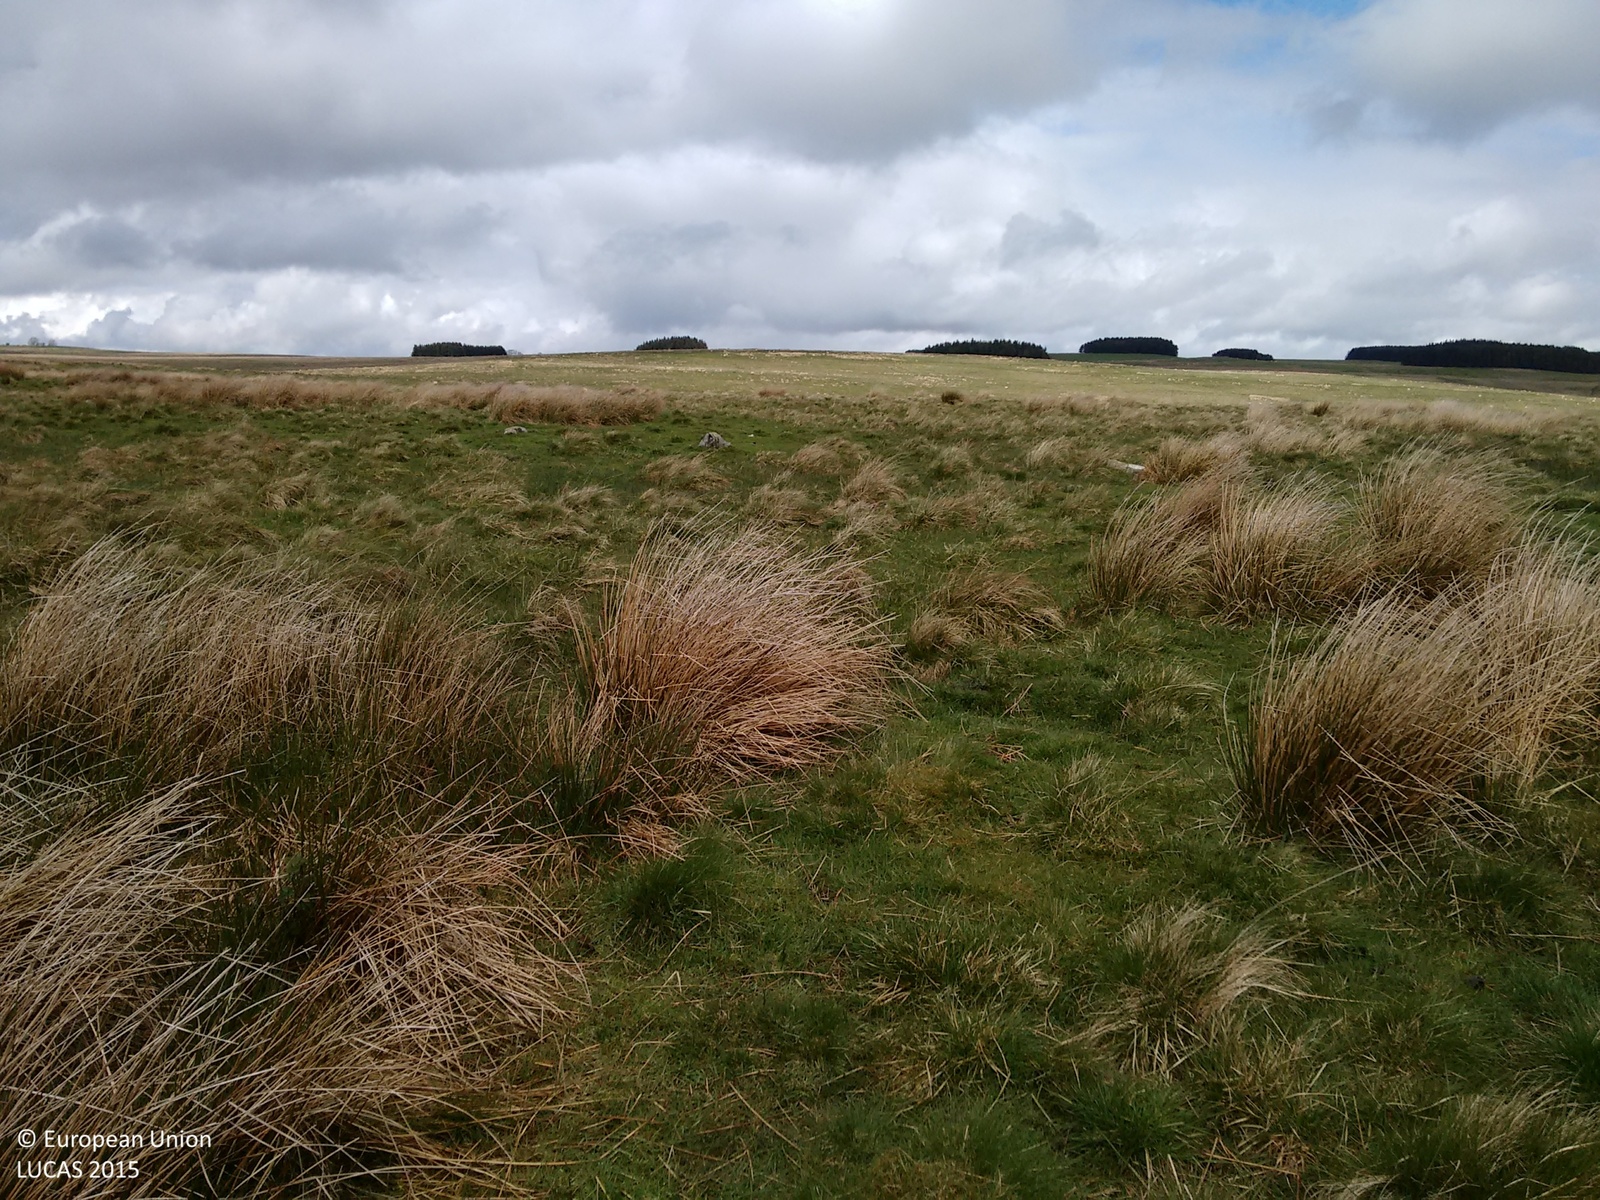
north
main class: Grassland
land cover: Grassland without tree/shrub cover
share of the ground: > 75 %
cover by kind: herbaceous plants 100 %
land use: Agriculture (excluding fallow land and kitchen gardens)
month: May
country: GB
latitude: 55.0194
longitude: -2.2105
